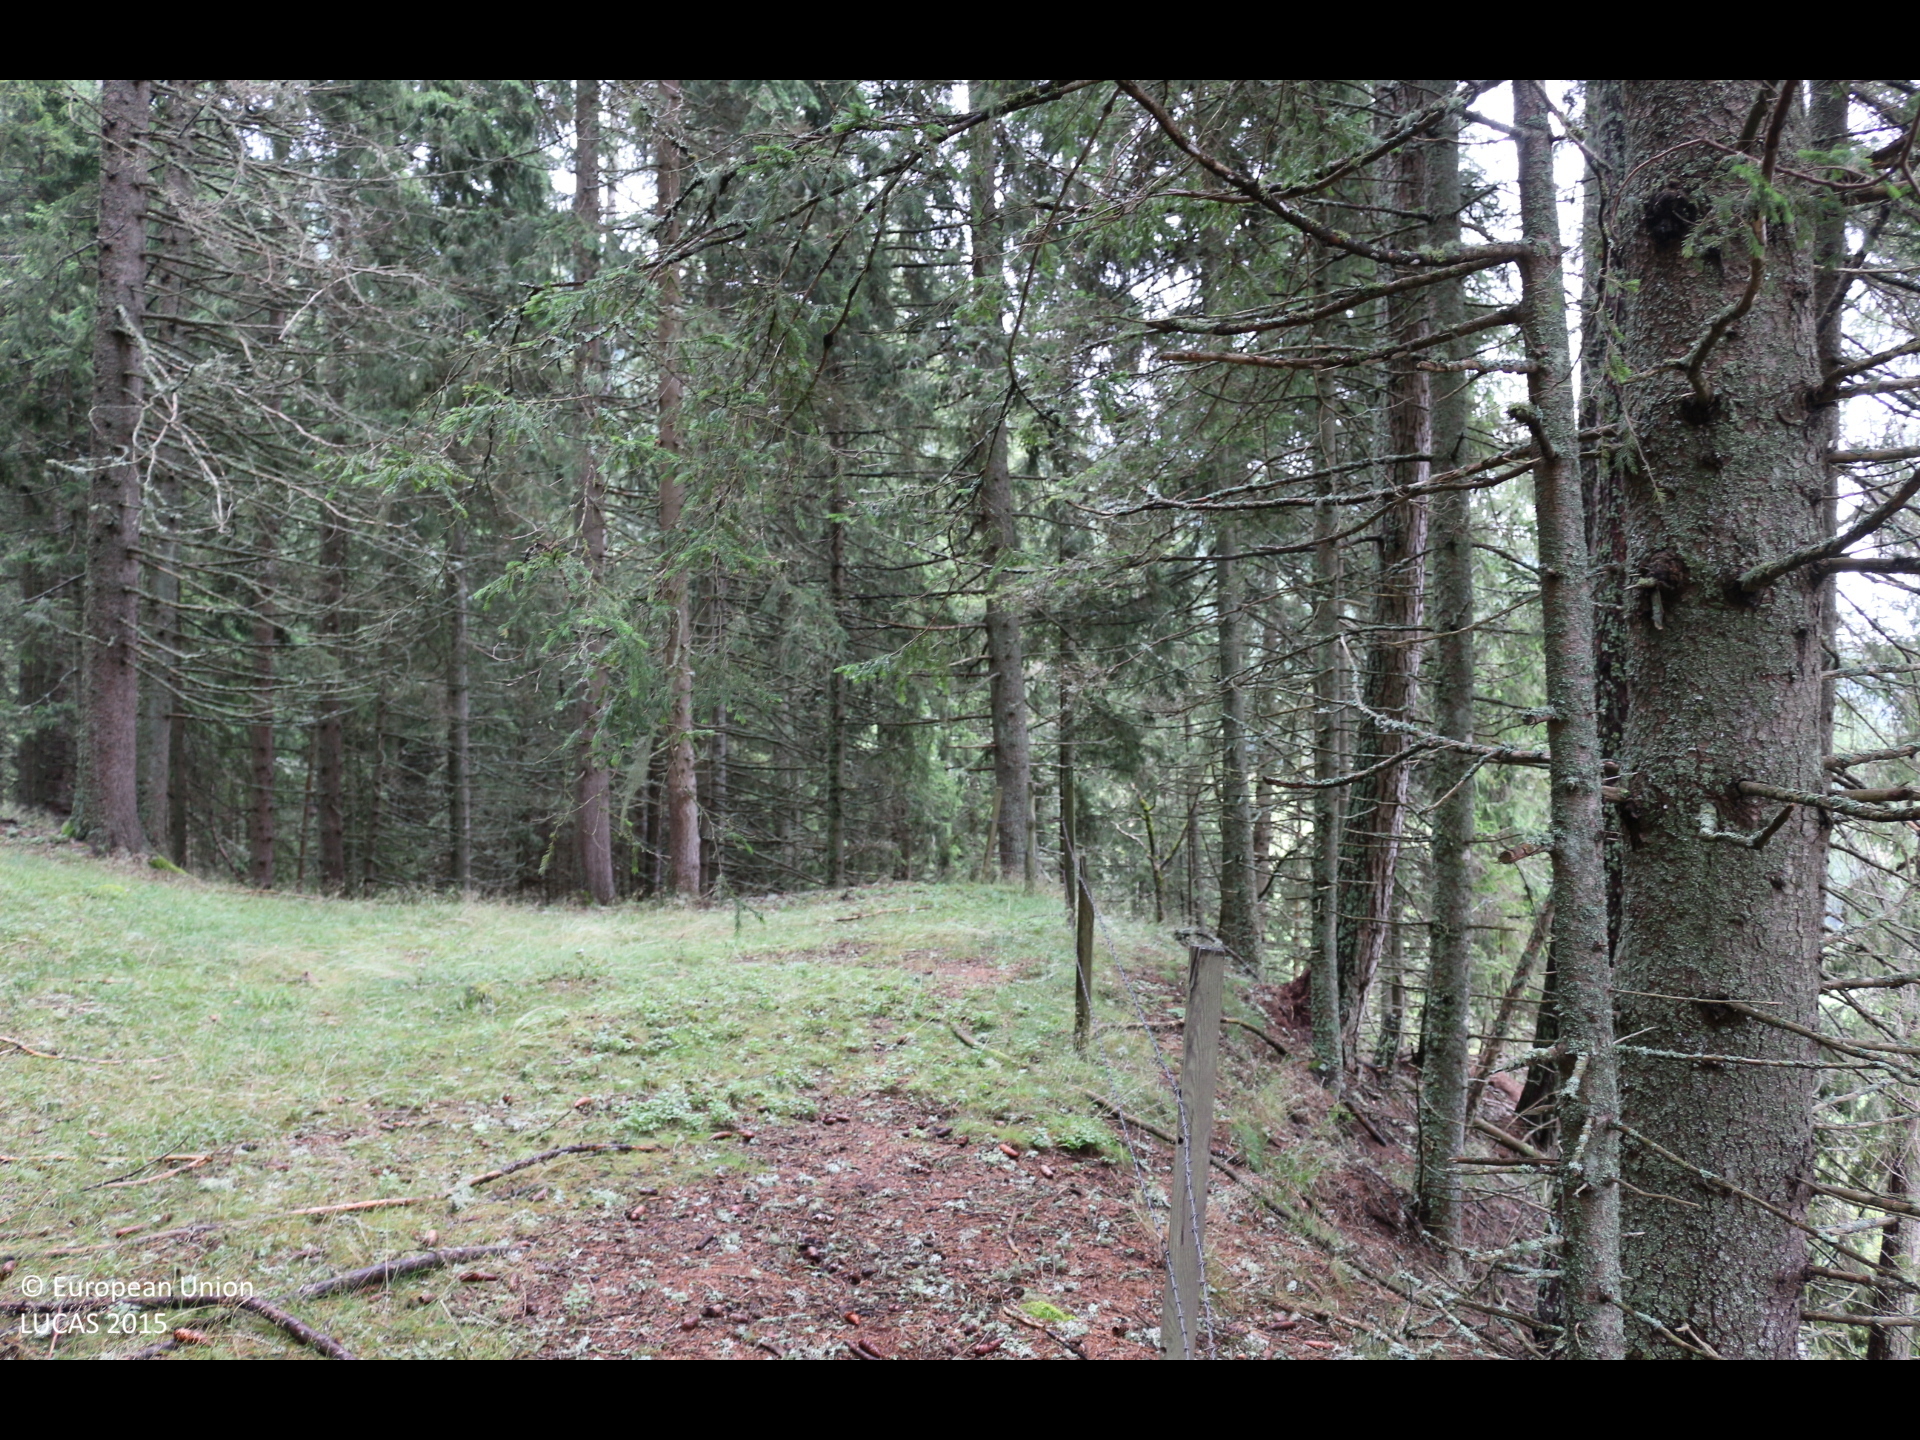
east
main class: Woodland
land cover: Spruce dominated coniferous woodland
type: alpine coniferous forest
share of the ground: > 75 %
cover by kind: coniferous forest trees 95 %, herbaceous plants 5 %
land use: Forestry
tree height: > 5 m
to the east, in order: Spruce dominated coniferous woodland; Fences; Spruce dominated coniferous woodland; Fences; Dry stone walls; Grassland without tree/shrub cover; Tracks; Grassland without tree/shrub cover; Spruce dominated mixed woodland; Rivers and streams; Spruce dominated mixed woodland; Fences; Grassland without tree/shrub cover; Fences; Grassland without tree/shrub cover; Spruce dominated coniferous woodland
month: July
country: AT
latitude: 47.0242
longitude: 14.2478
